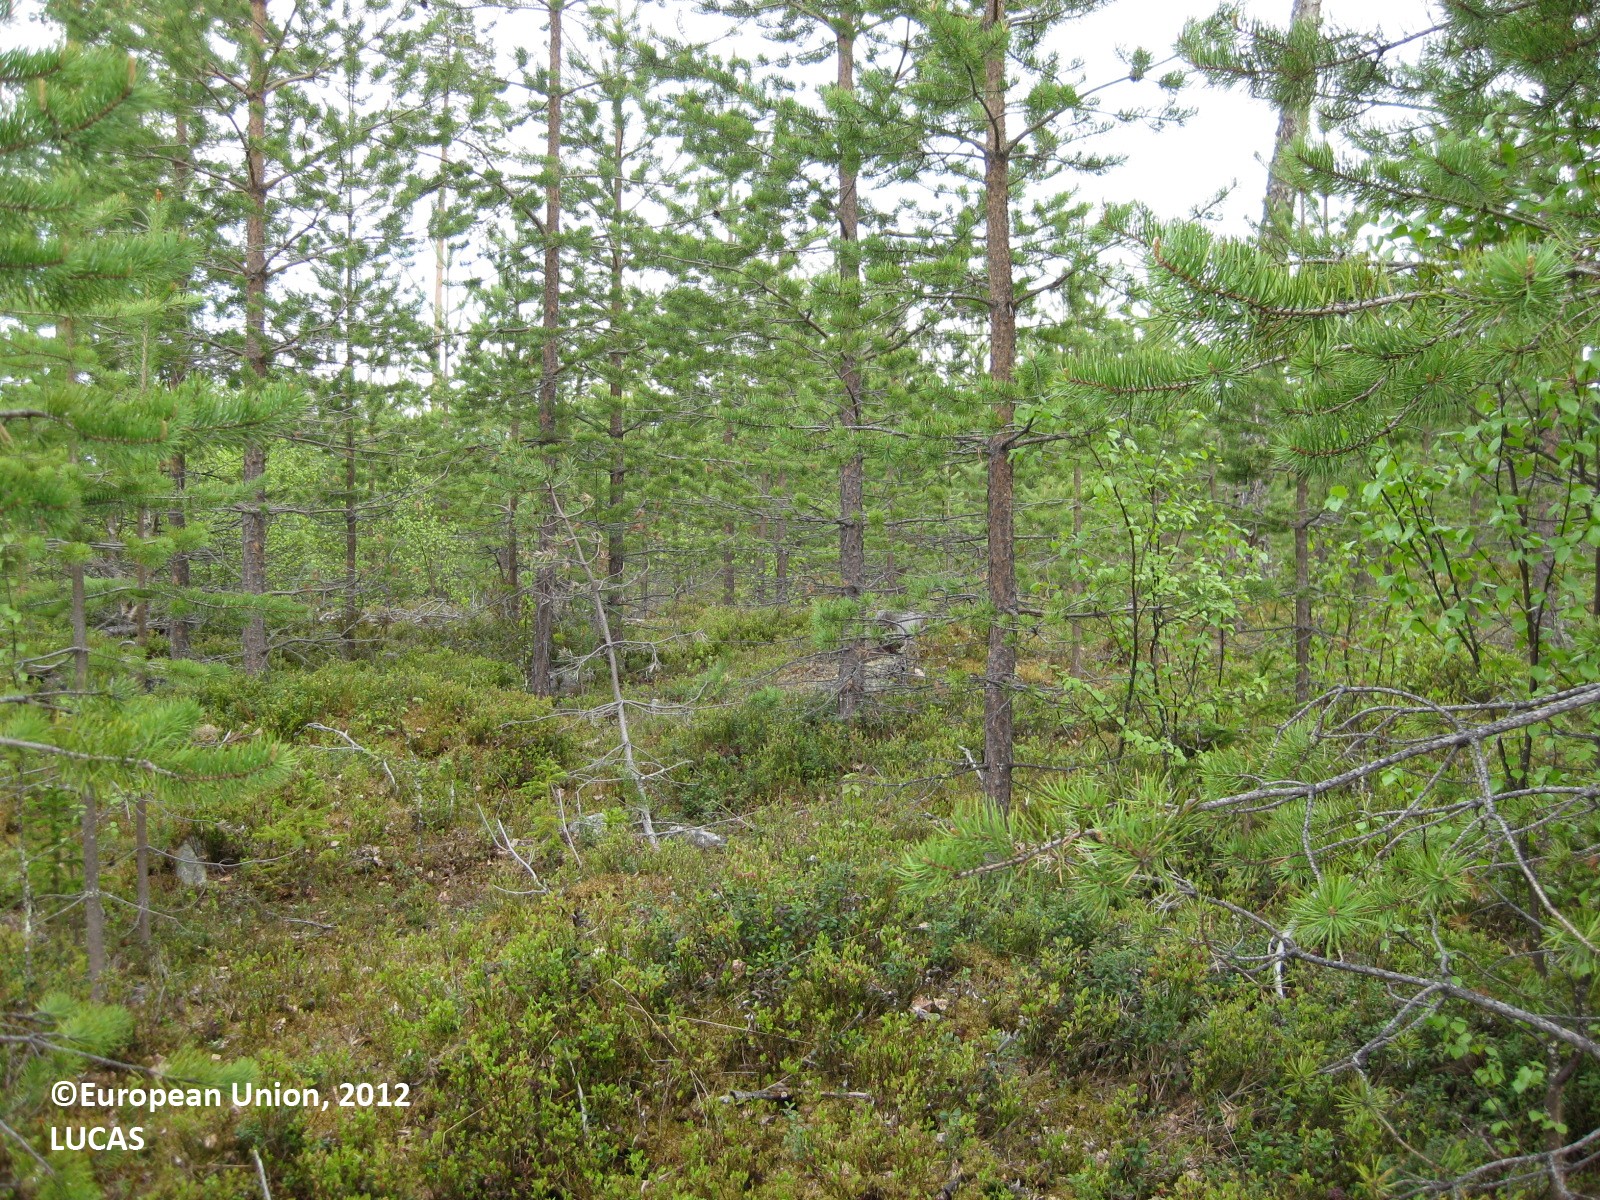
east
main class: Woodland
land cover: Pine dominated coniferous woodland
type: boreal forest
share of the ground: 50 - 75 %
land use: Forestry
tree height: < 5 m
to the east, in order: Pine dominated coniferous woodland; Ditches and canals; Pine dominated coniferous woodland
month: June
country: FI
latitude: 65.3672
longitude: 29.3084
